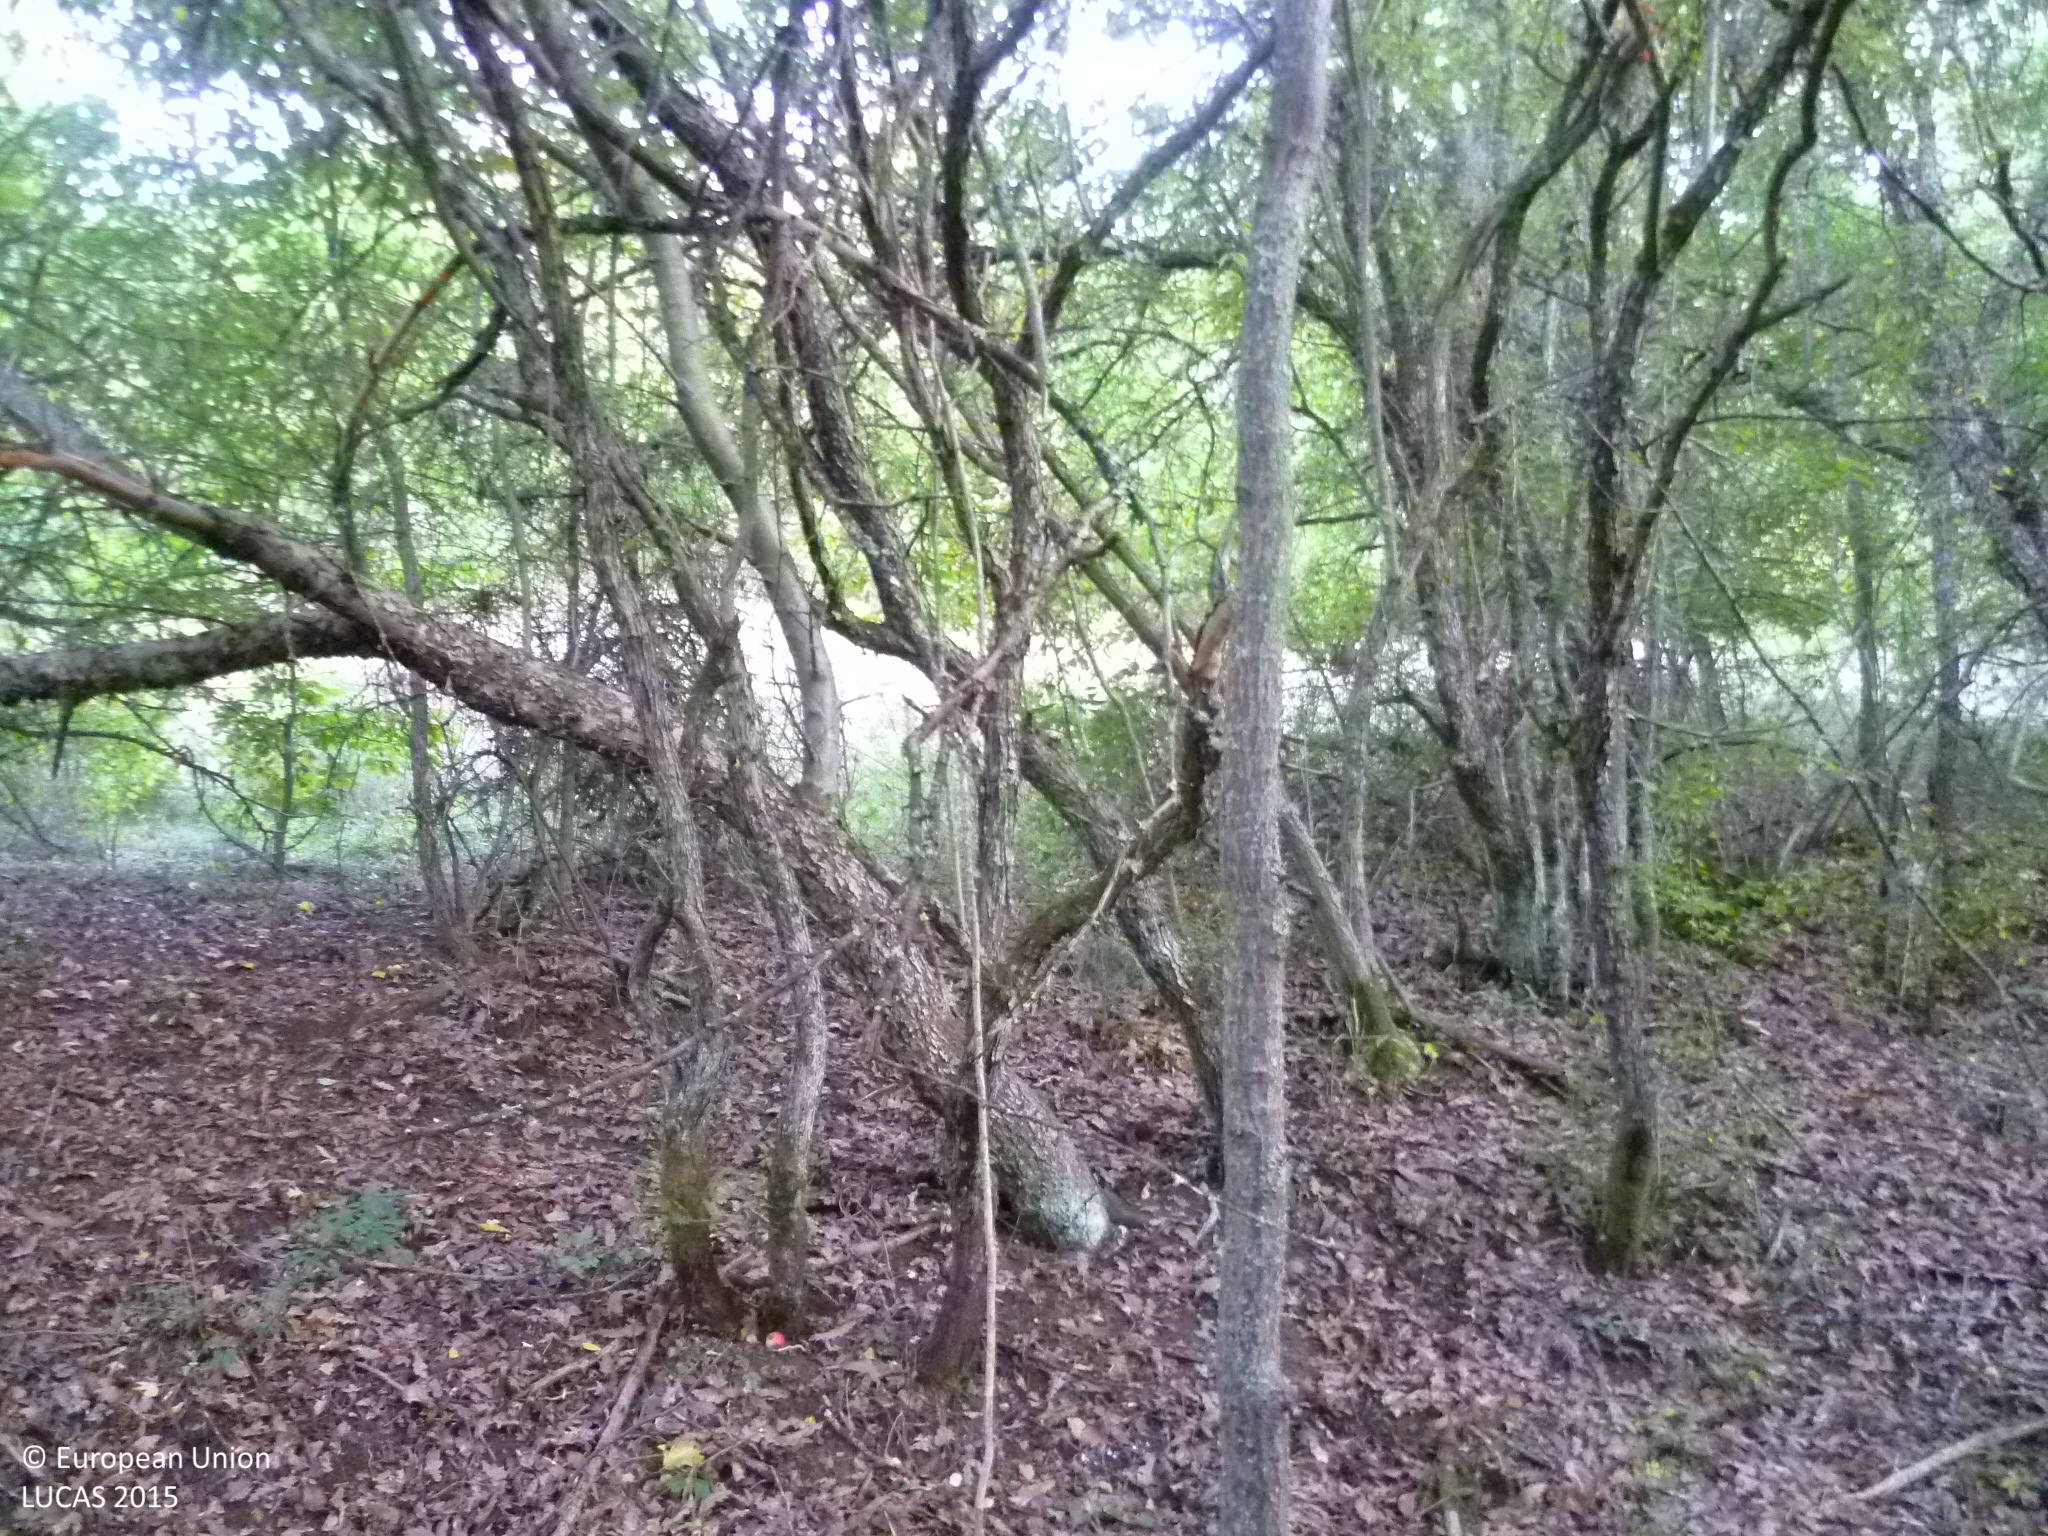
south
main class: Woodland
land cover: Broadleaved woodland
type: mesophytic deciduous forest
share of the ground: 50 - 75 %
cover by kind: broadleaved forest trees 60 %, unconsolidated bare surface 30 %, shrubs 5 %, lichens and mosses 5 %
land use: Forestry
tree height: > 5 m
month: October
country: BG
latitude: 42.8234
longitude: 22.6619
